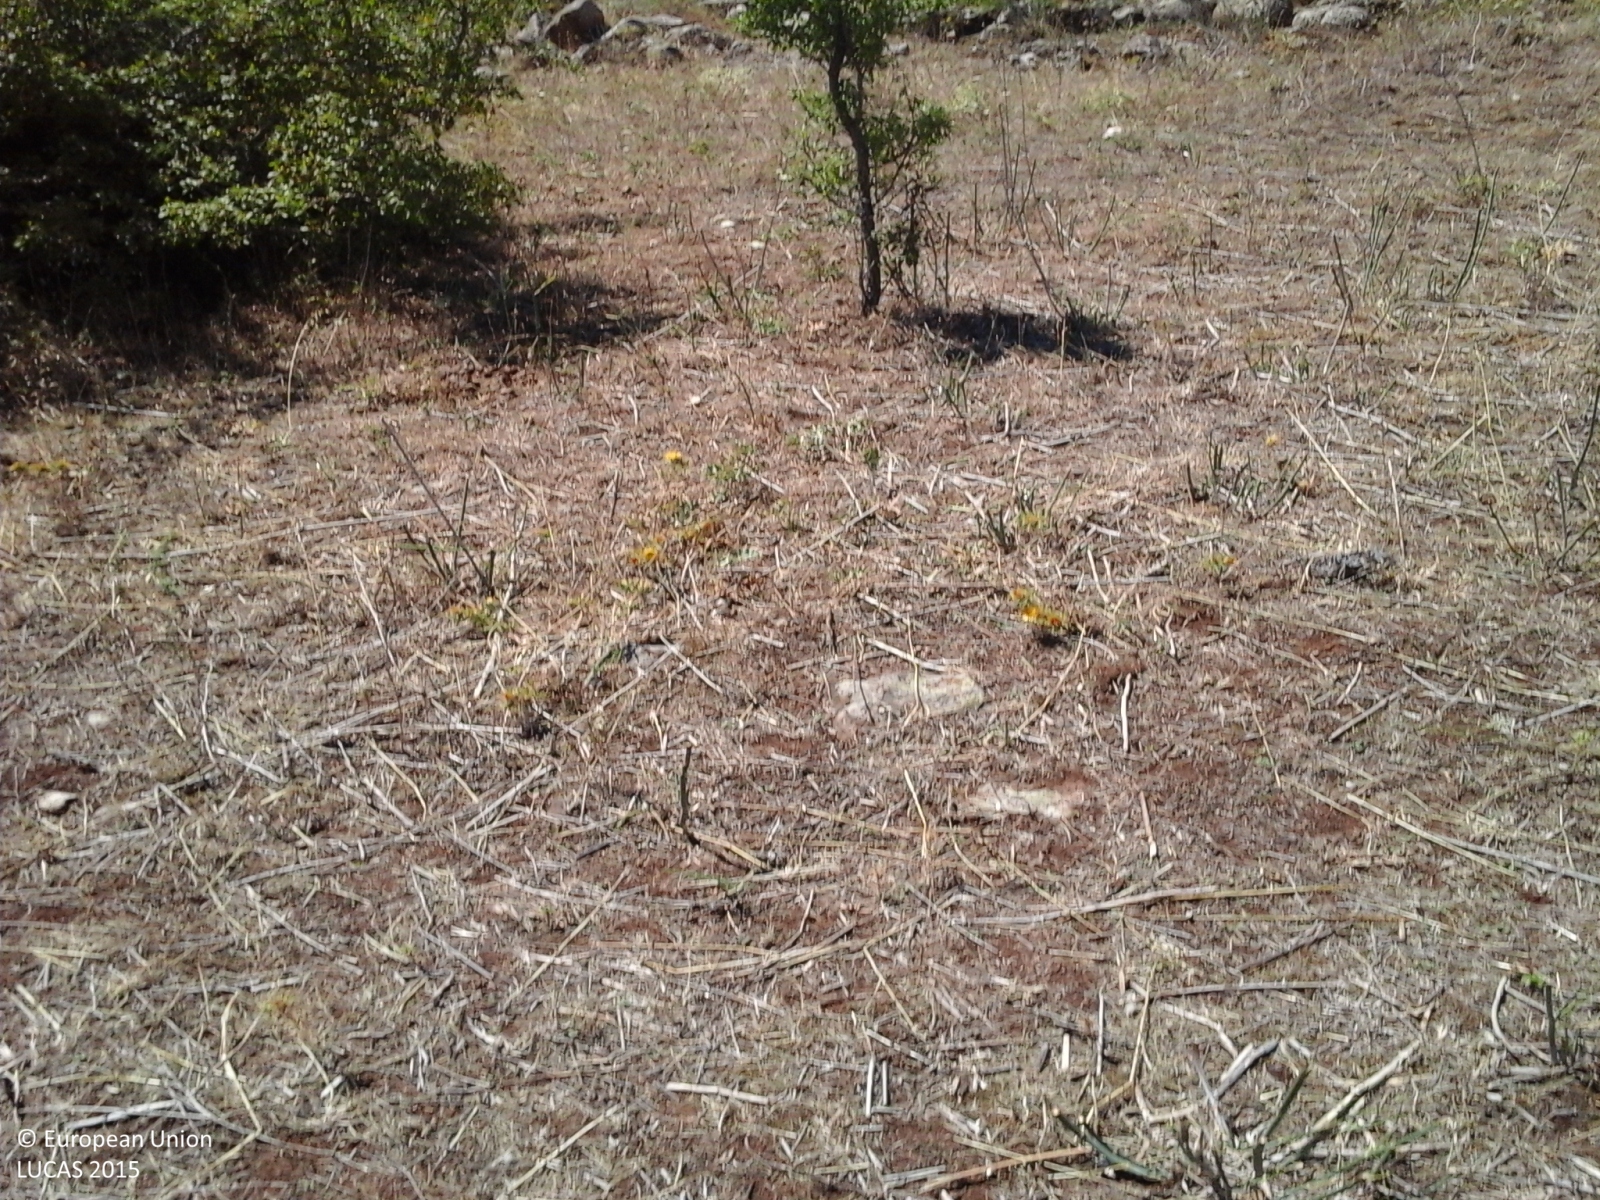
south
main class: Shrubland
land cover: Shrubland without tree cover
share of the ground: > 75 %
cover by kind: herbaceous plants 70 %, shrubs 30 %
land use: Agriculture (excluding fallow land and kitchen gardens)
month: July
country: IT
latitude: 37.1129
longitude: 14.8804
